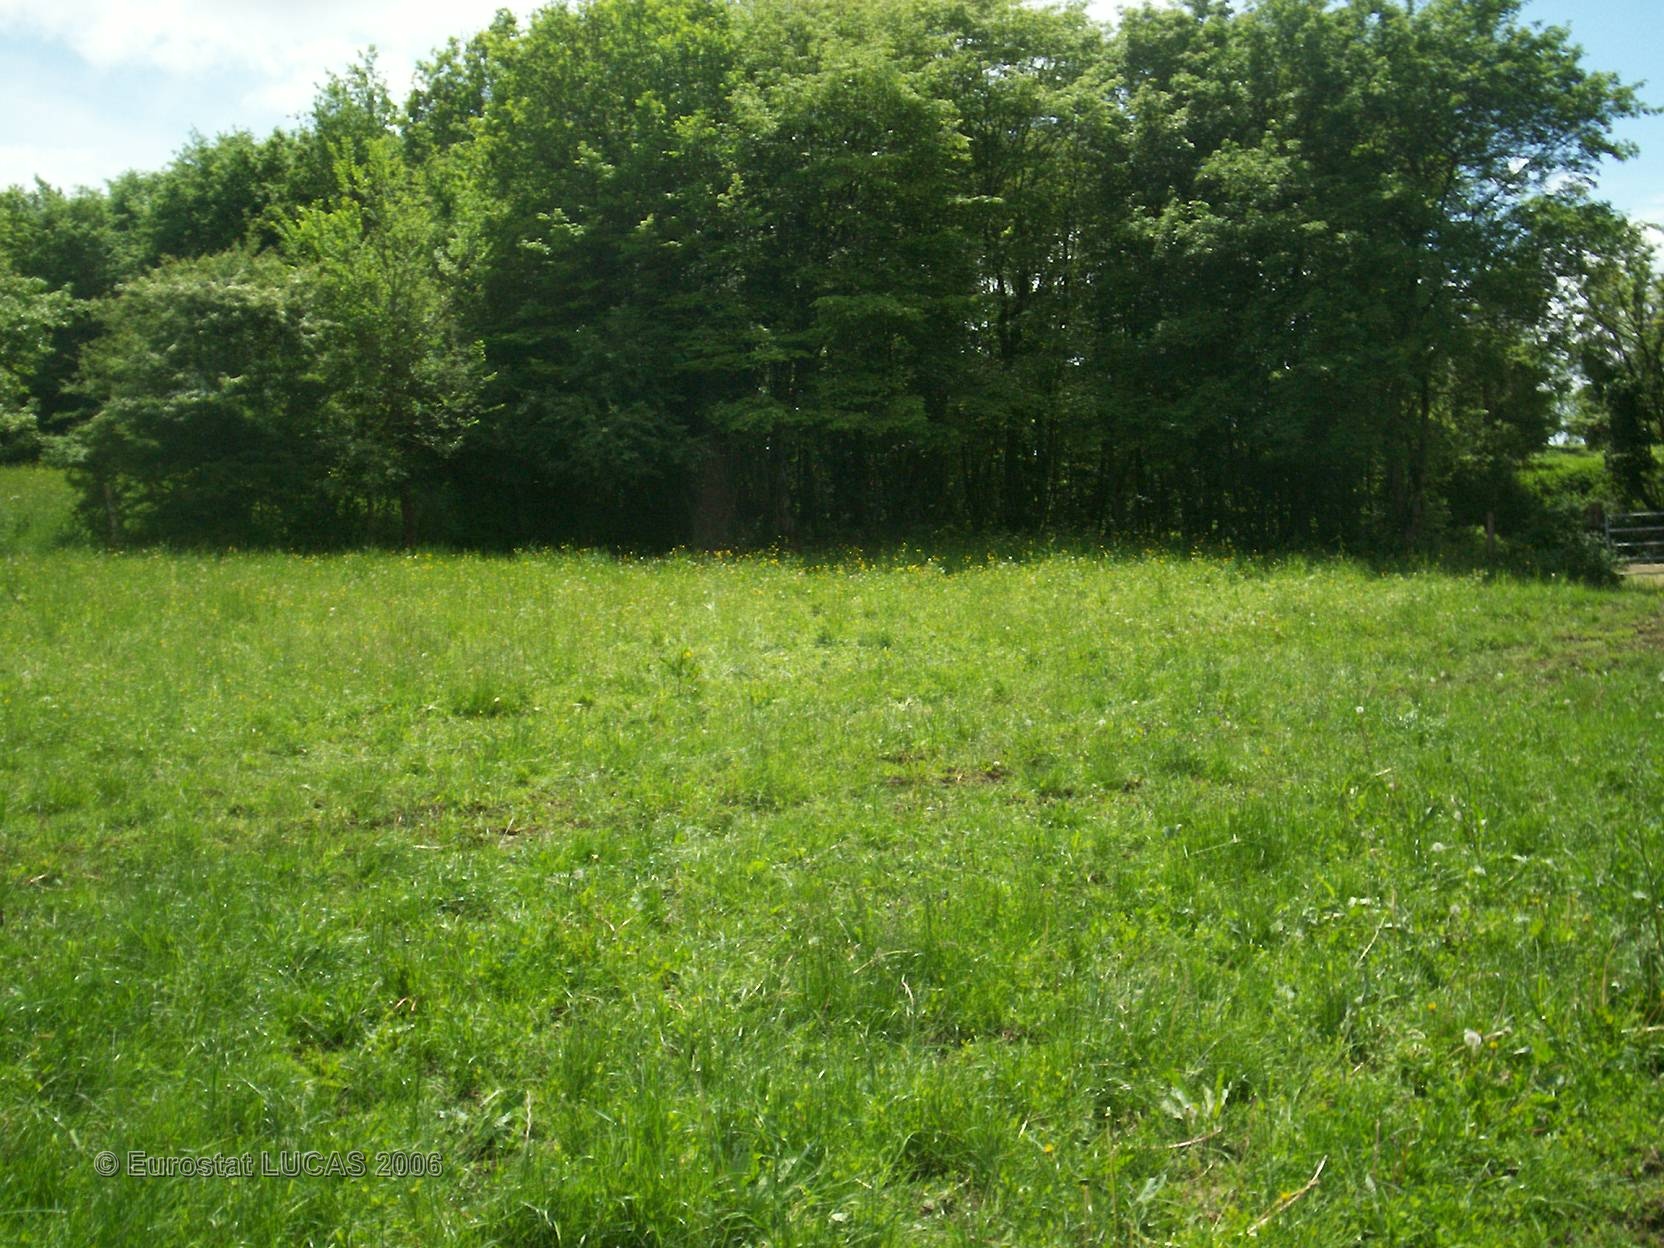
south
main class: Grassland
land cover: Grassland without tree/shrub cover
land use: Agriculture (excluding fallow land and kitchen gardens)
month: May
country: FR
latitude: 46.9907
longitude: 4.5962
